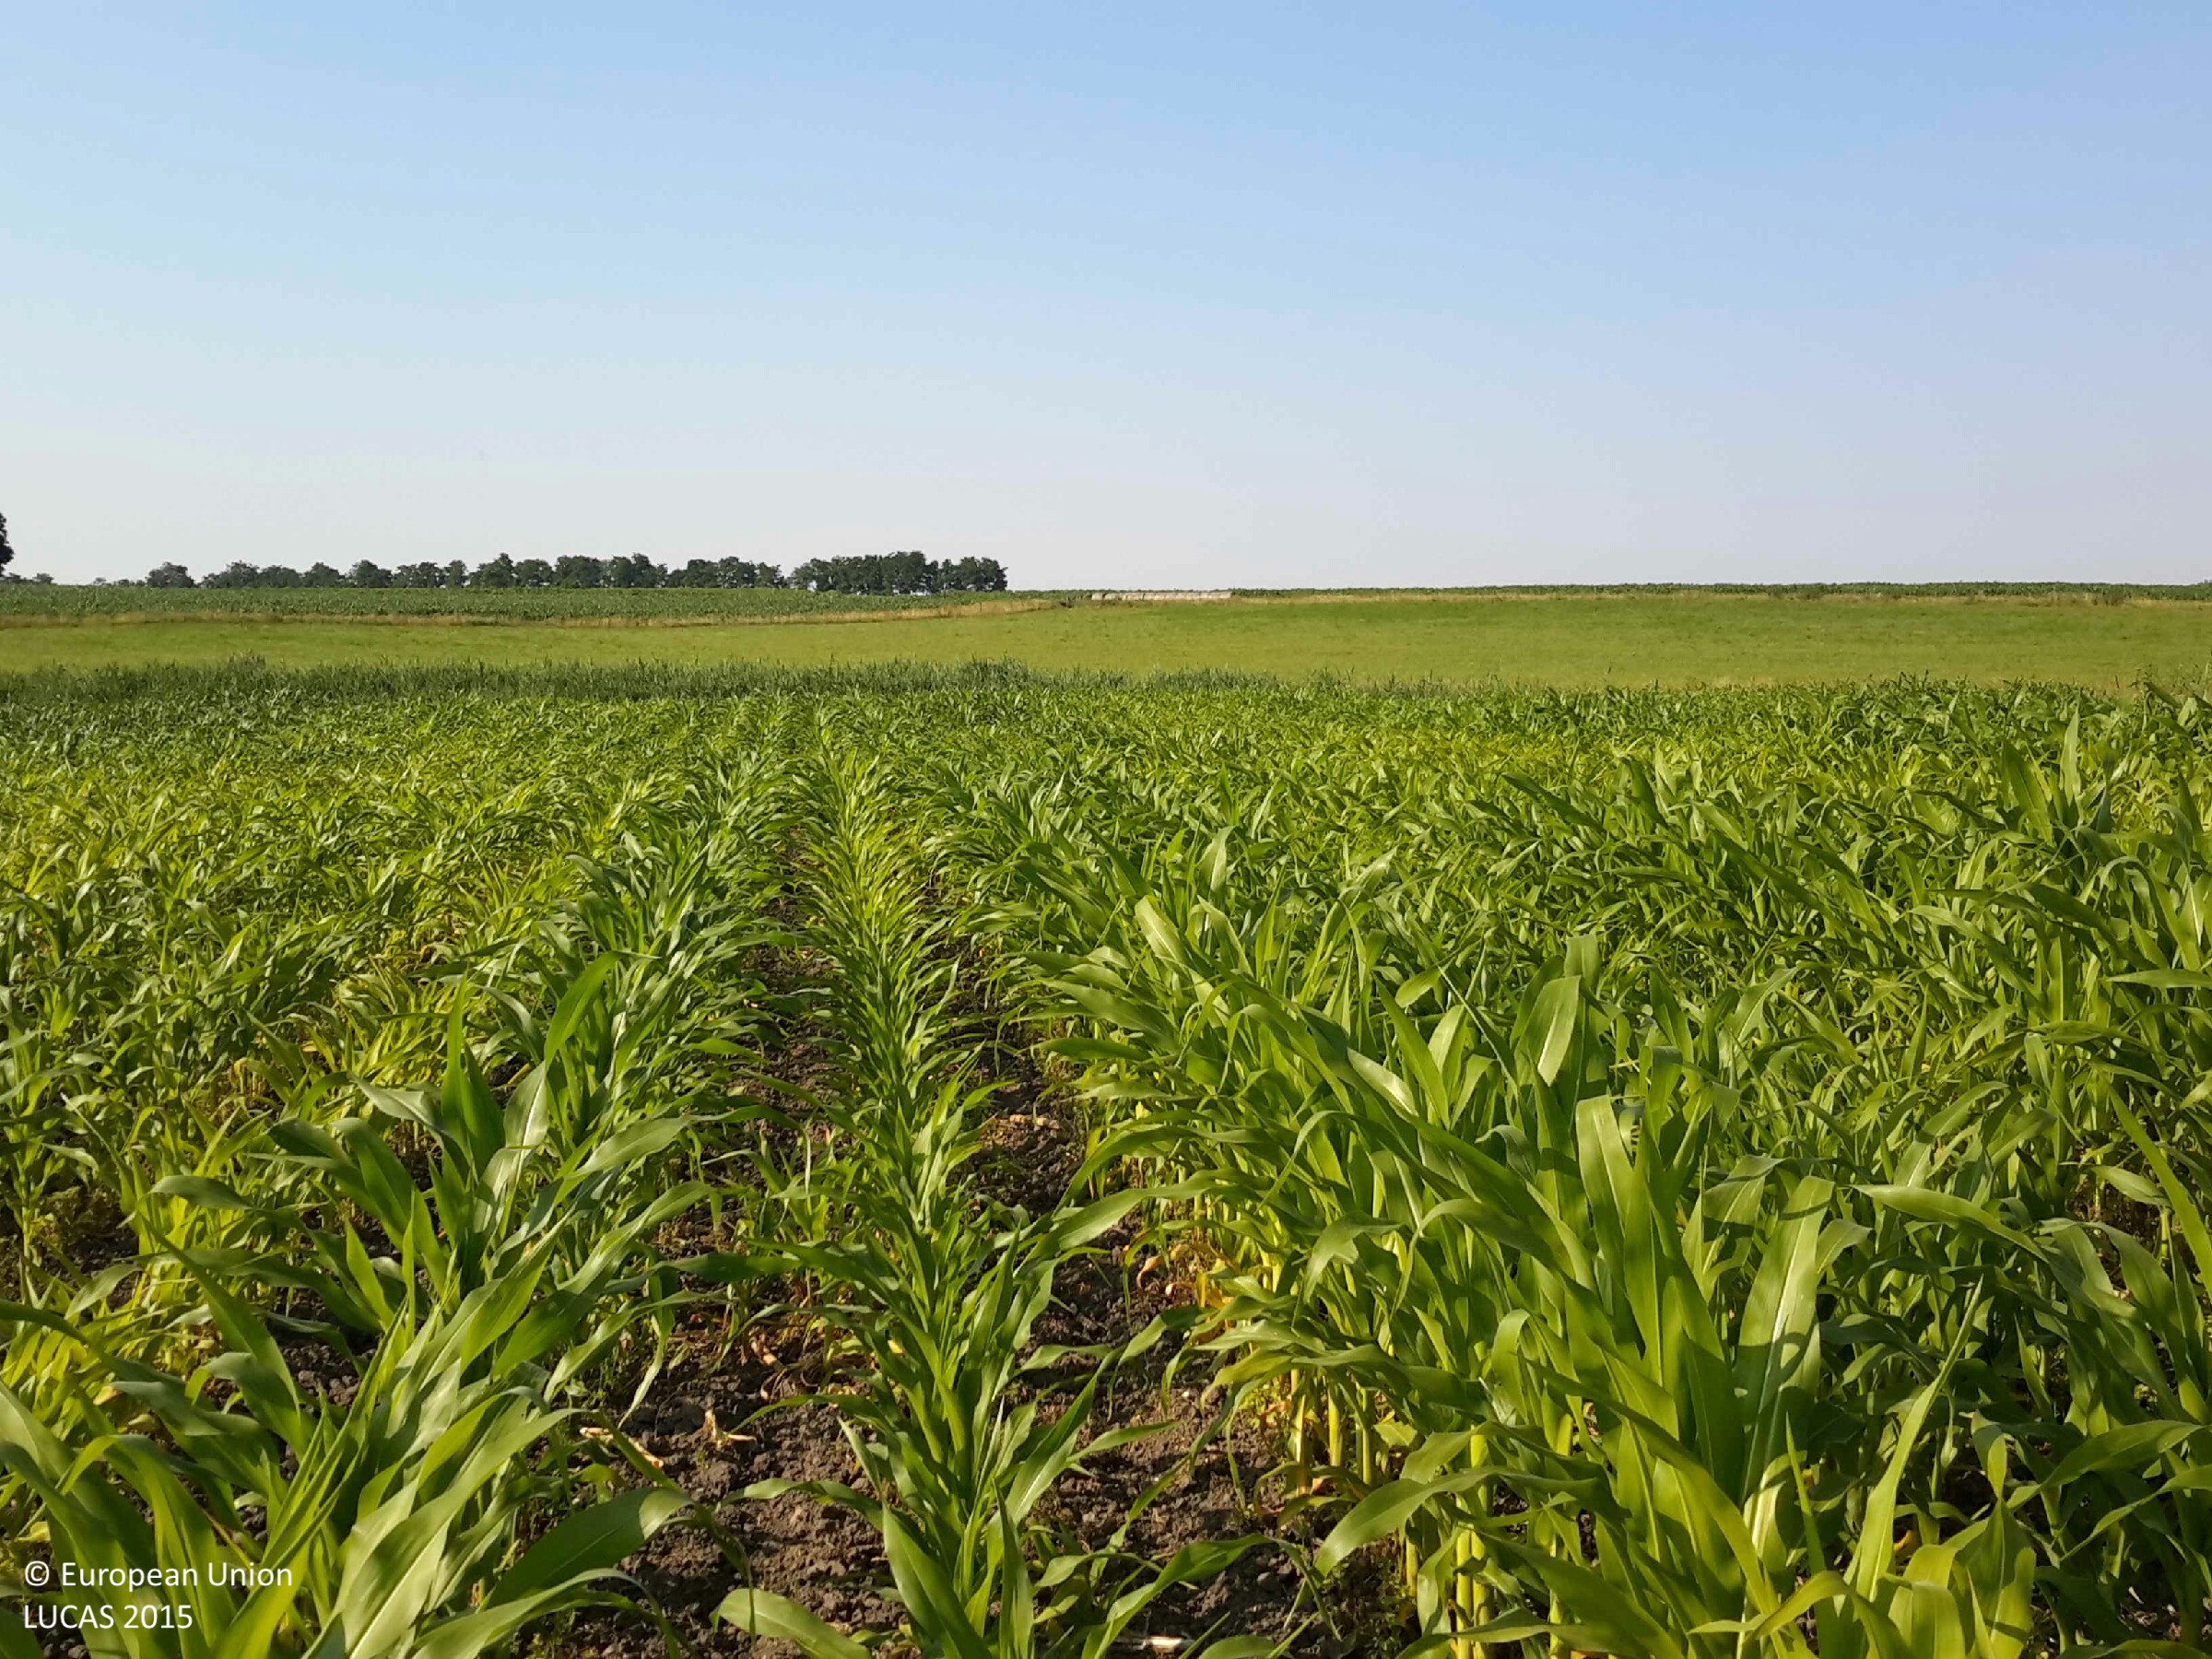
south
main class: Cropland
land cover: Maize
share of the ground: 50 - 75 %
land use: Agriculture (excluding fallow land and kitchen gardens)
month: July
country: HU
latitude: 47.4419
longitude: 17.5268
